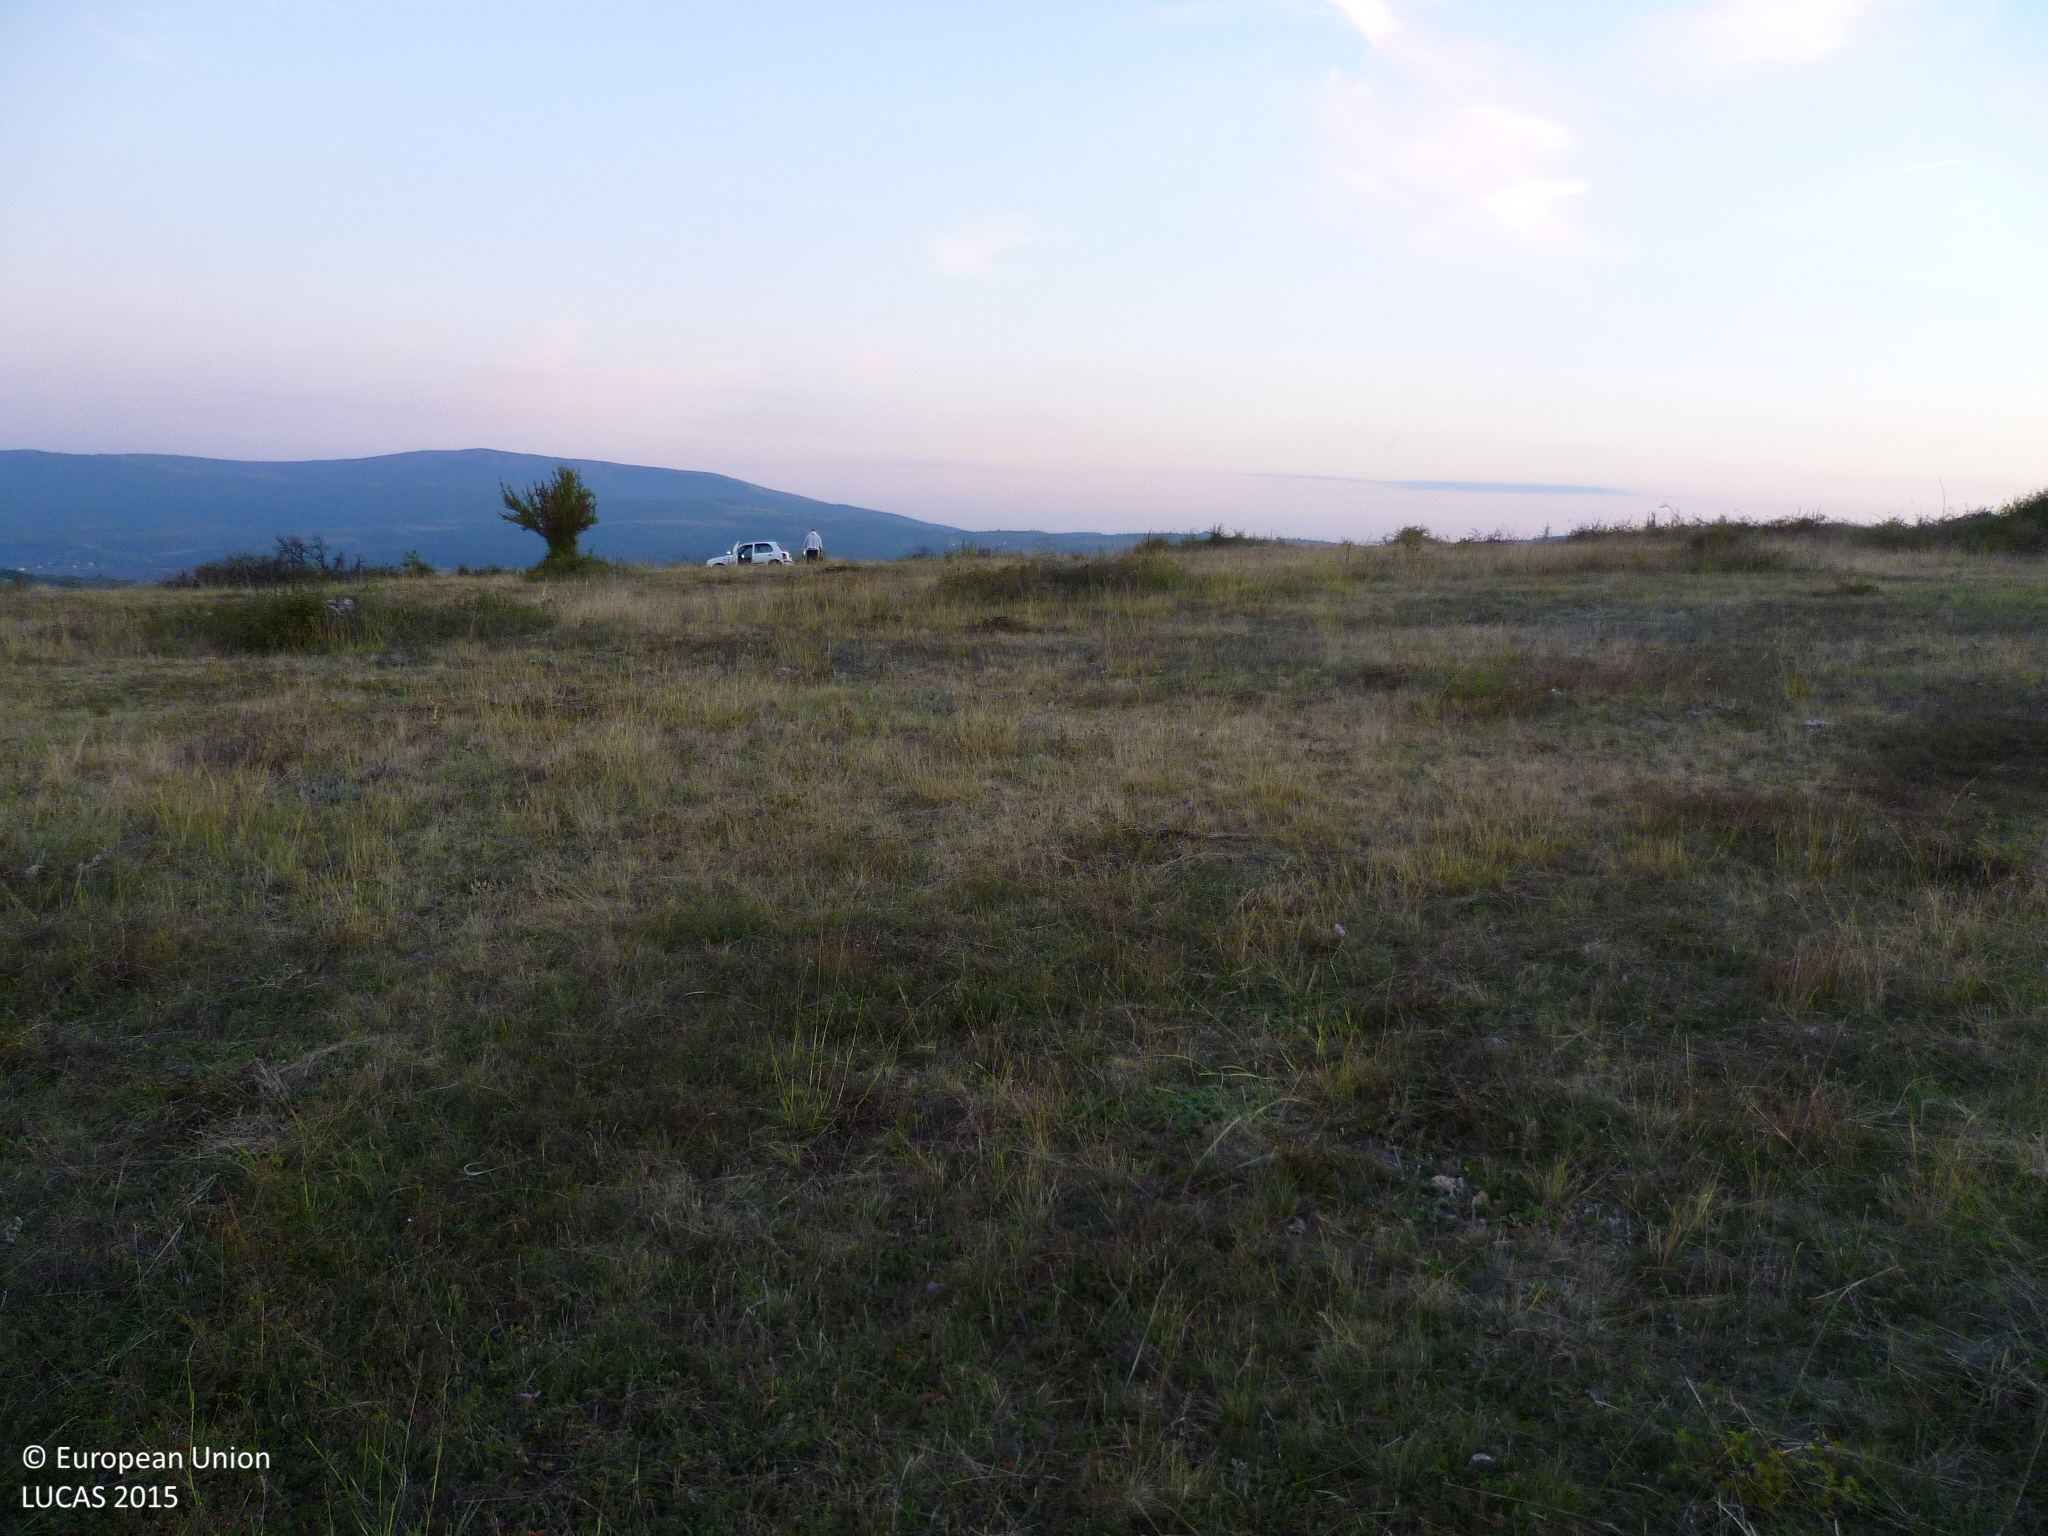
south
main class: Grassland
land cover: Grassland without tree/shrub cover
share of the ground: > 75 %
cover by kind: herbaceous plants 100 %
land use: Agriculture (excluding fallow land and kitchen gardens)
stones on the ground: > 50 %
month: October
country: BG
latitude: 43.0267
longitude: 22.9298
